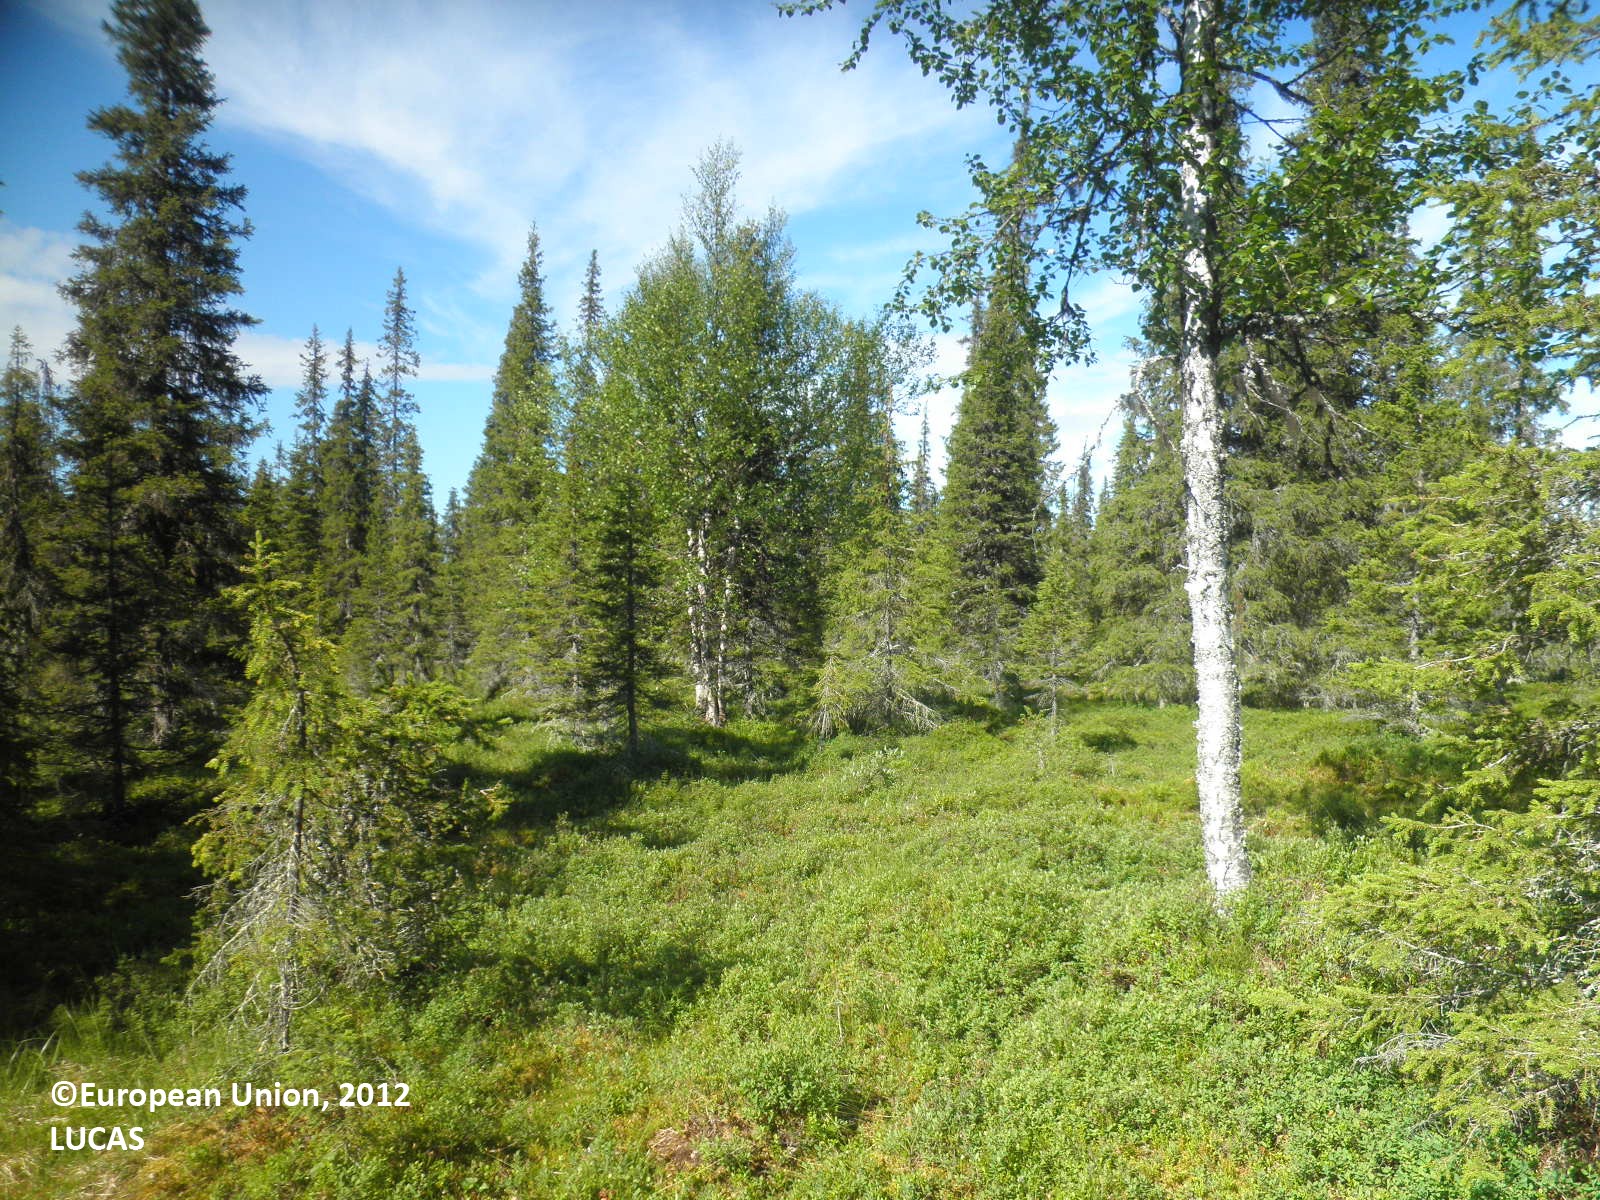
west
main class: Woodland
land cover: Spruce dominated mixed woodland
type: boreal forest
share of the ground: 25 - 50 %
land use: Forestry
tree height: > 5 m
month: July
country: FI
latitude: 67.7126
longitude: 26.2471
